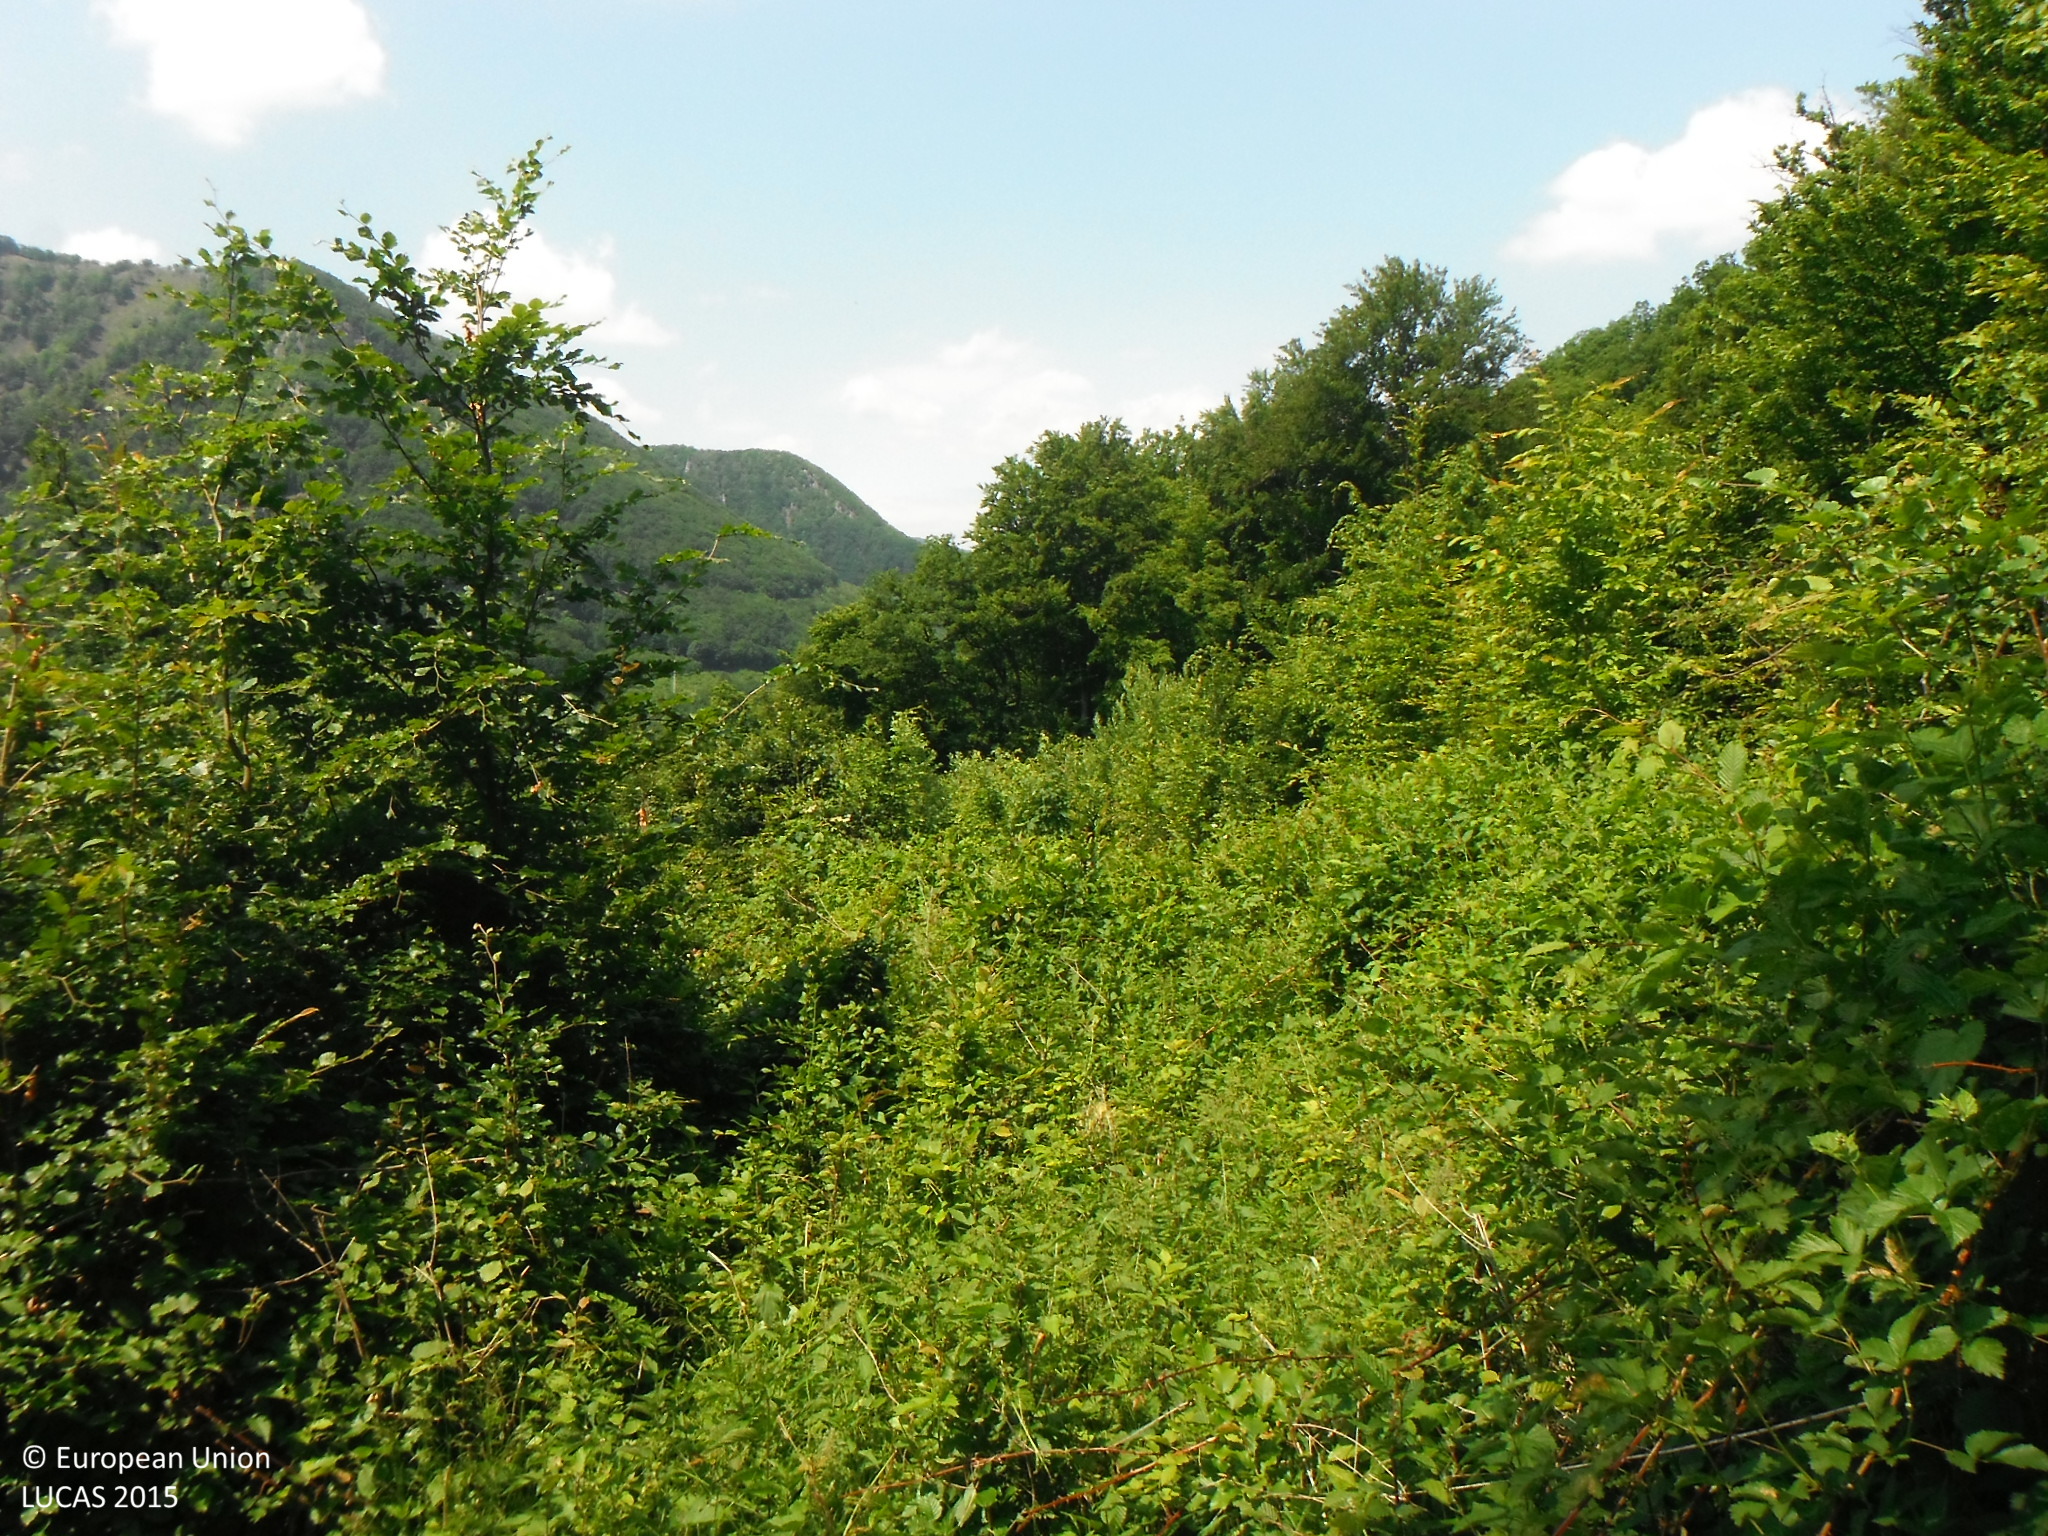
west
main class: Woodland
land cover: Broadleaved woodland
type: beech forest
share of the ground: 50 - 75 %
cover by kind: broadleaved forest trees 60 %, herbaceous plants 40 %
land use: Forestry
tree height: < 5 m
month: June
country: SK
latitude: 48.8723
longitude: 21.1553
